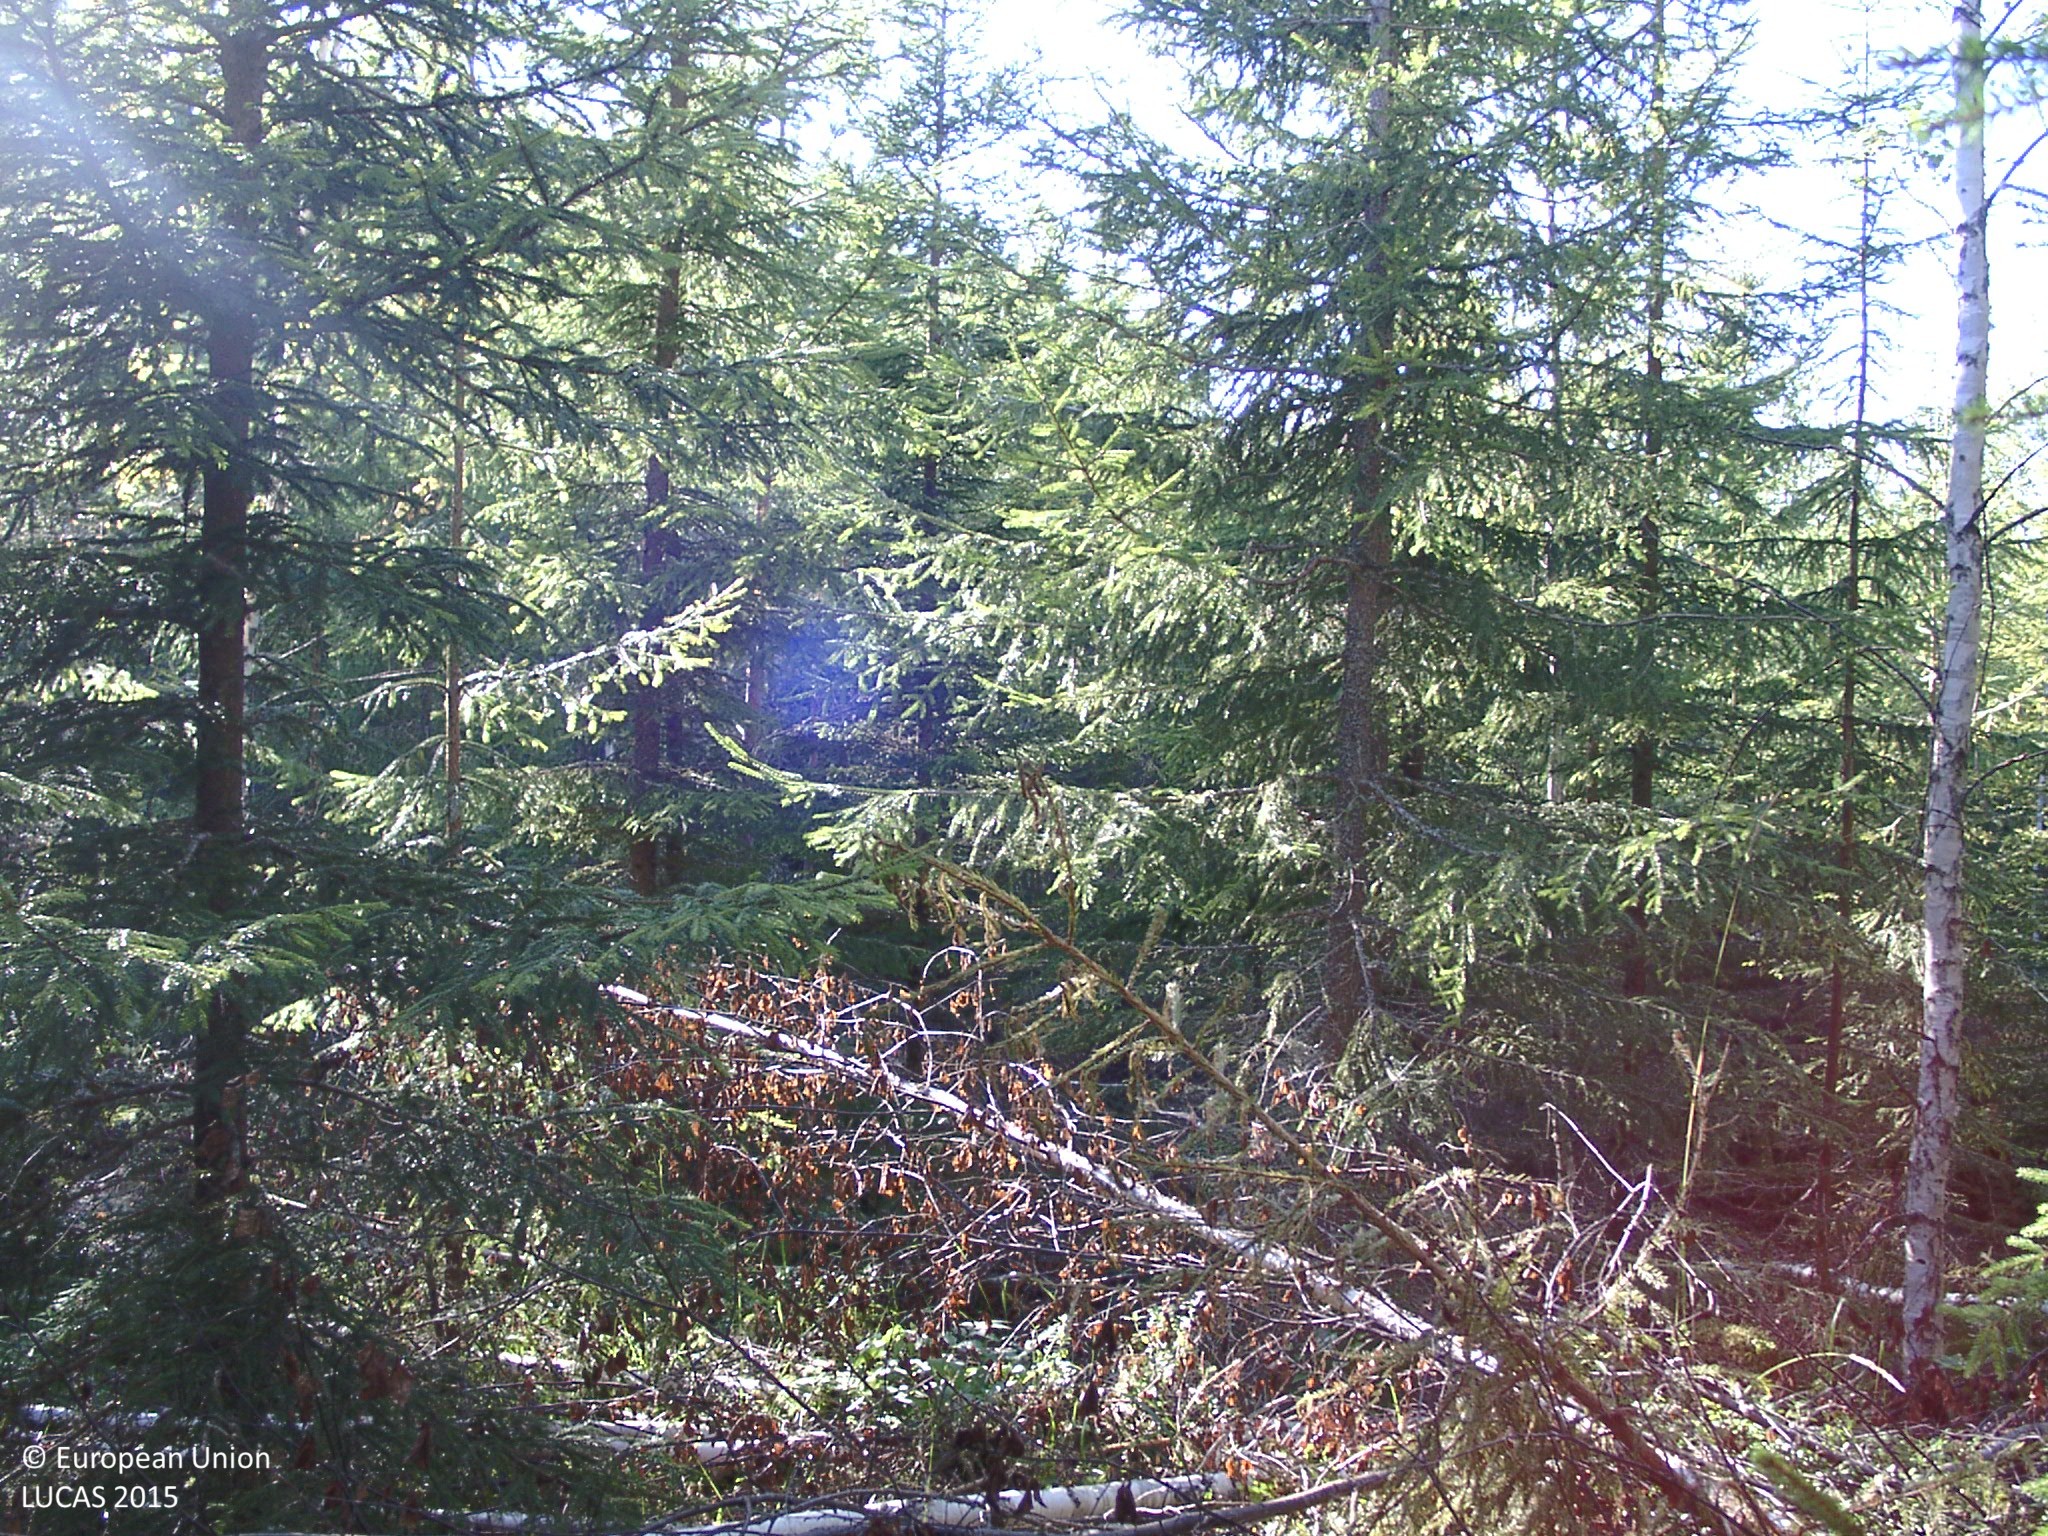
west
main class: Woodland
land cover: Spruce dominated coniferous woodland
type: boreal forest
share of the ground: 50 - 75 %
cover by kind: coniferous forest trees 60 %, broadleaved forest trees 5 %, herbaceous plants 5 %, lichens and mosses 5 %, unconsolidated bare surface 5 %
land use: Forestry
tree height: > 5 m
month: August
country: FI
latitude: 61.6949
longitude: 25.2953
